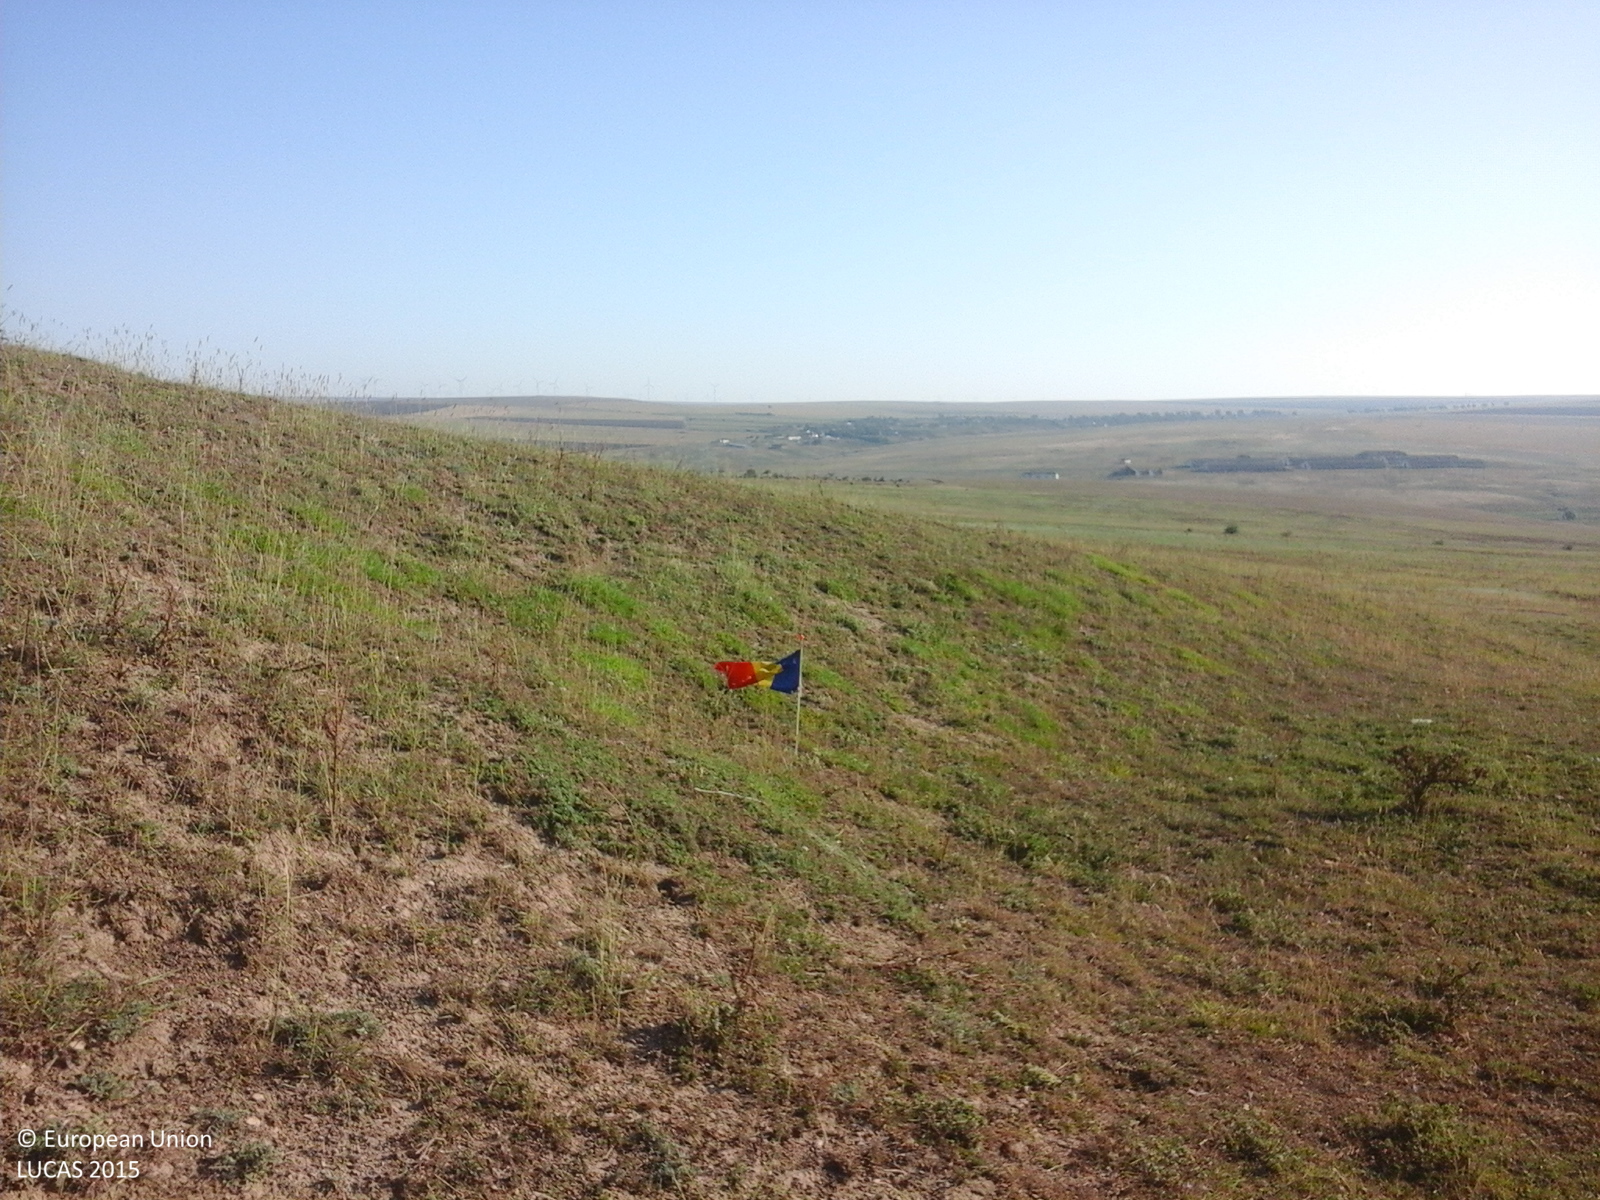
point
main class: Grassland
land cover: Grassland without tree/shrub cover
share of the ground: > 75 %
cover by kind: herbaceous plants 100 %
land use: Agriculture (excluding fallow land and kitchen gardens)
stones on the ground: > 50 %
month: August
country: RO
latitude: 44.4586
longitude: 28.5104
